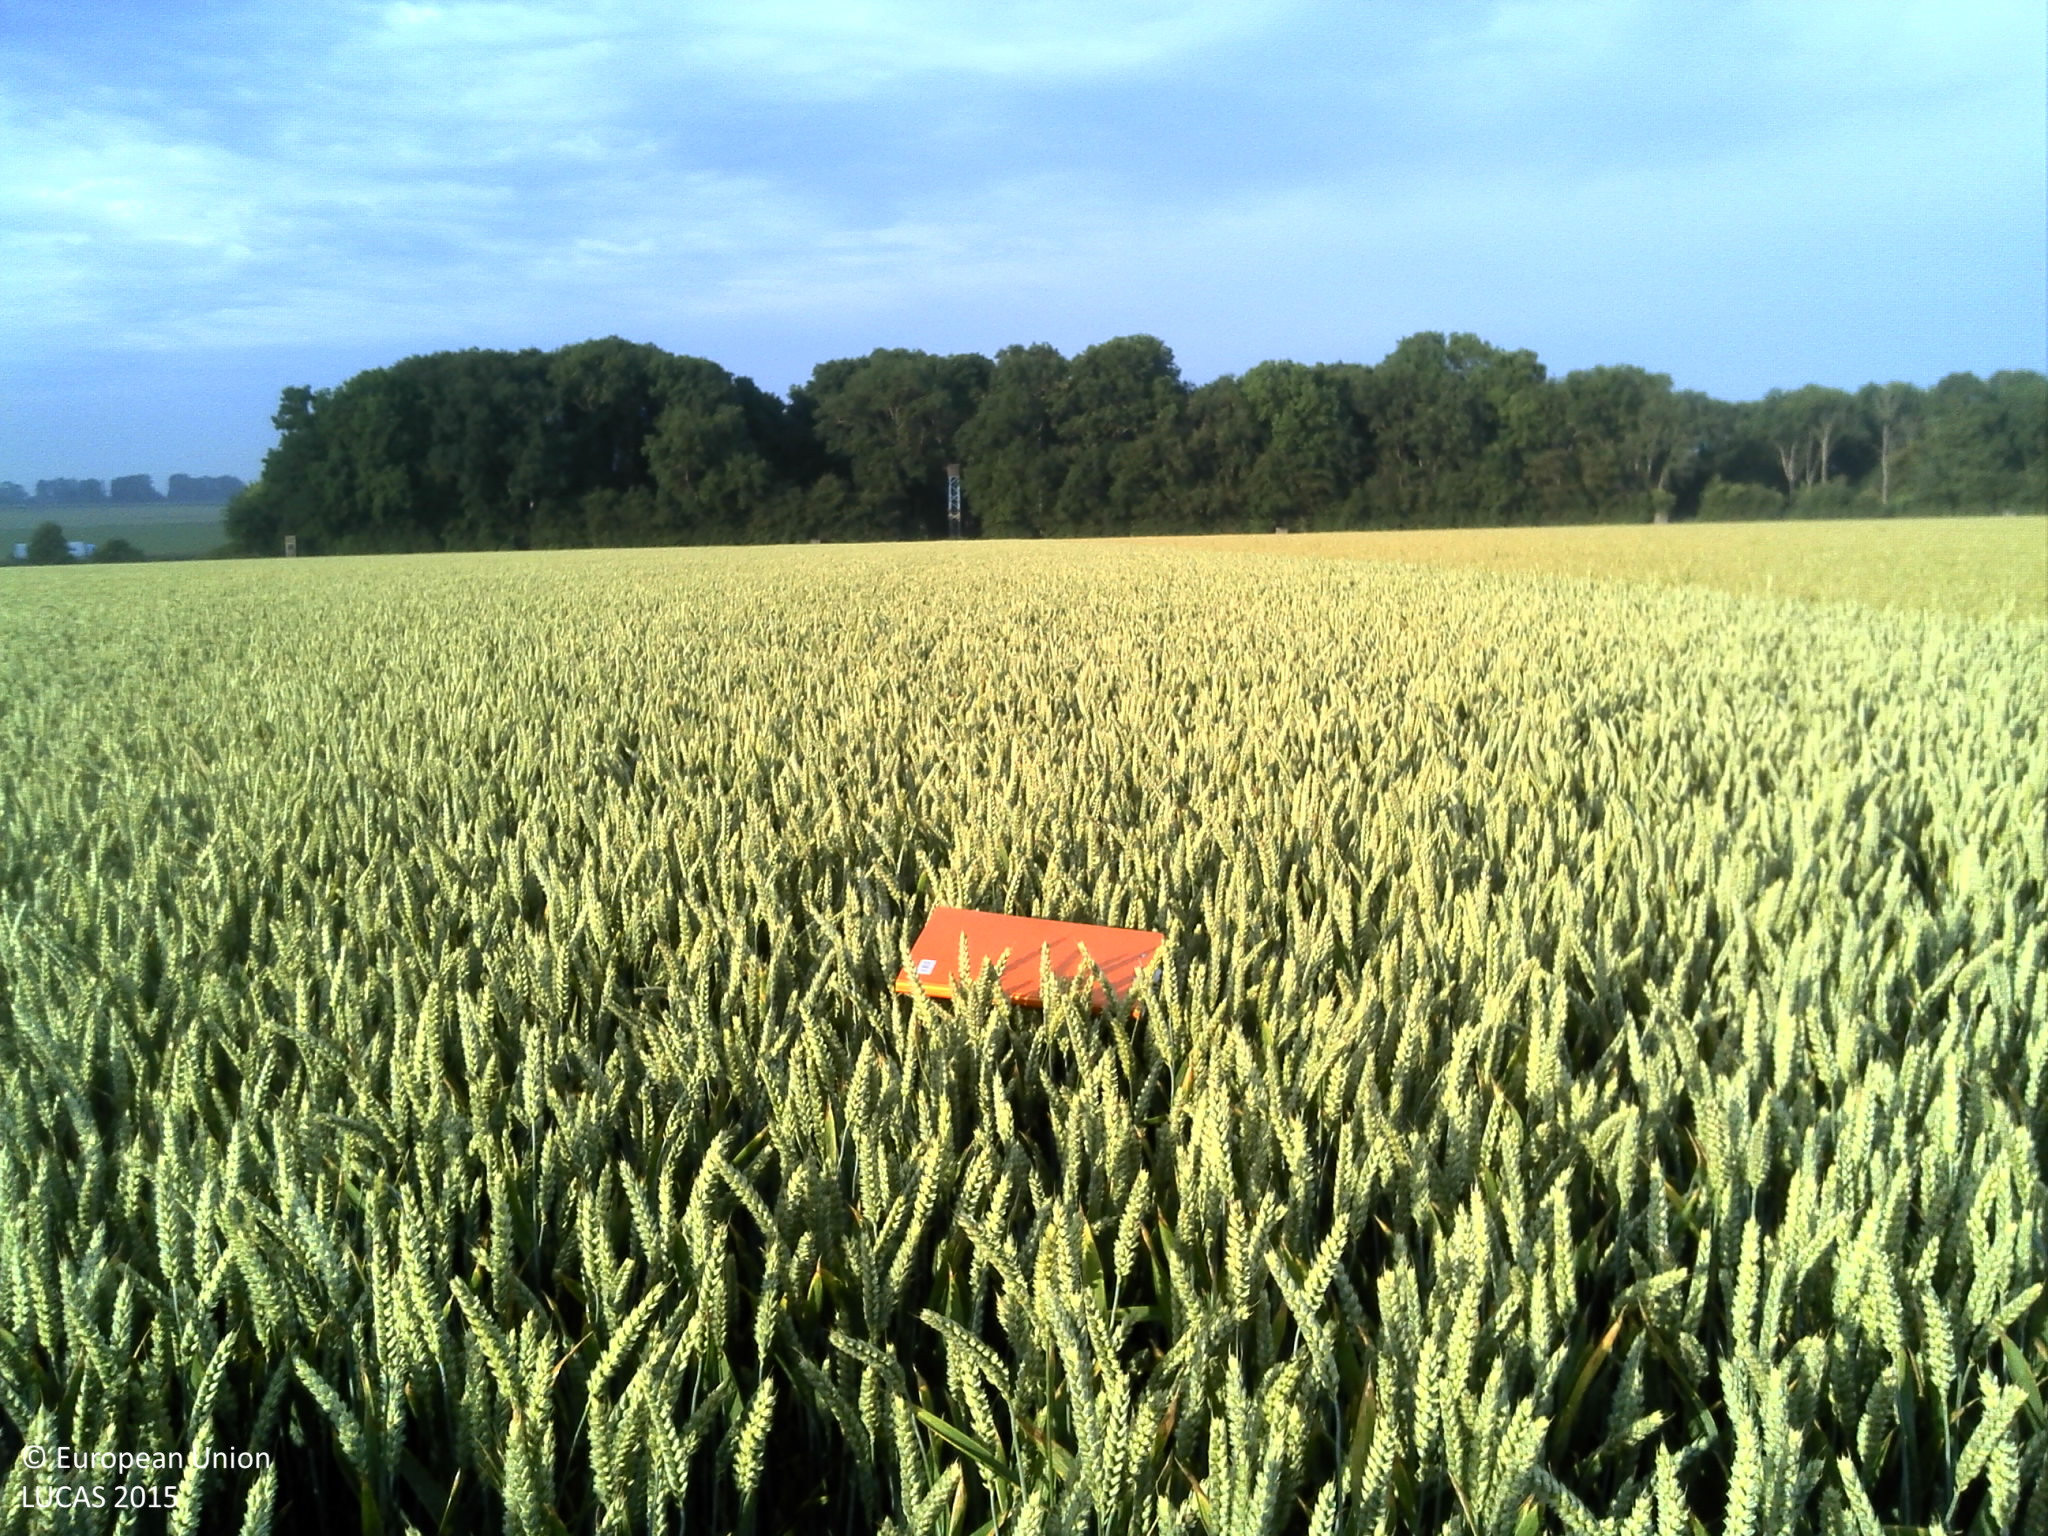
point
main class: Cropland
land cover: Common wheat
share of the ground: > 75 %
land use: Agriculture (excluding fallow land and kitchen gardens)
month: July
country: FR
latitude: 49.8754
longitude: 0.9179
